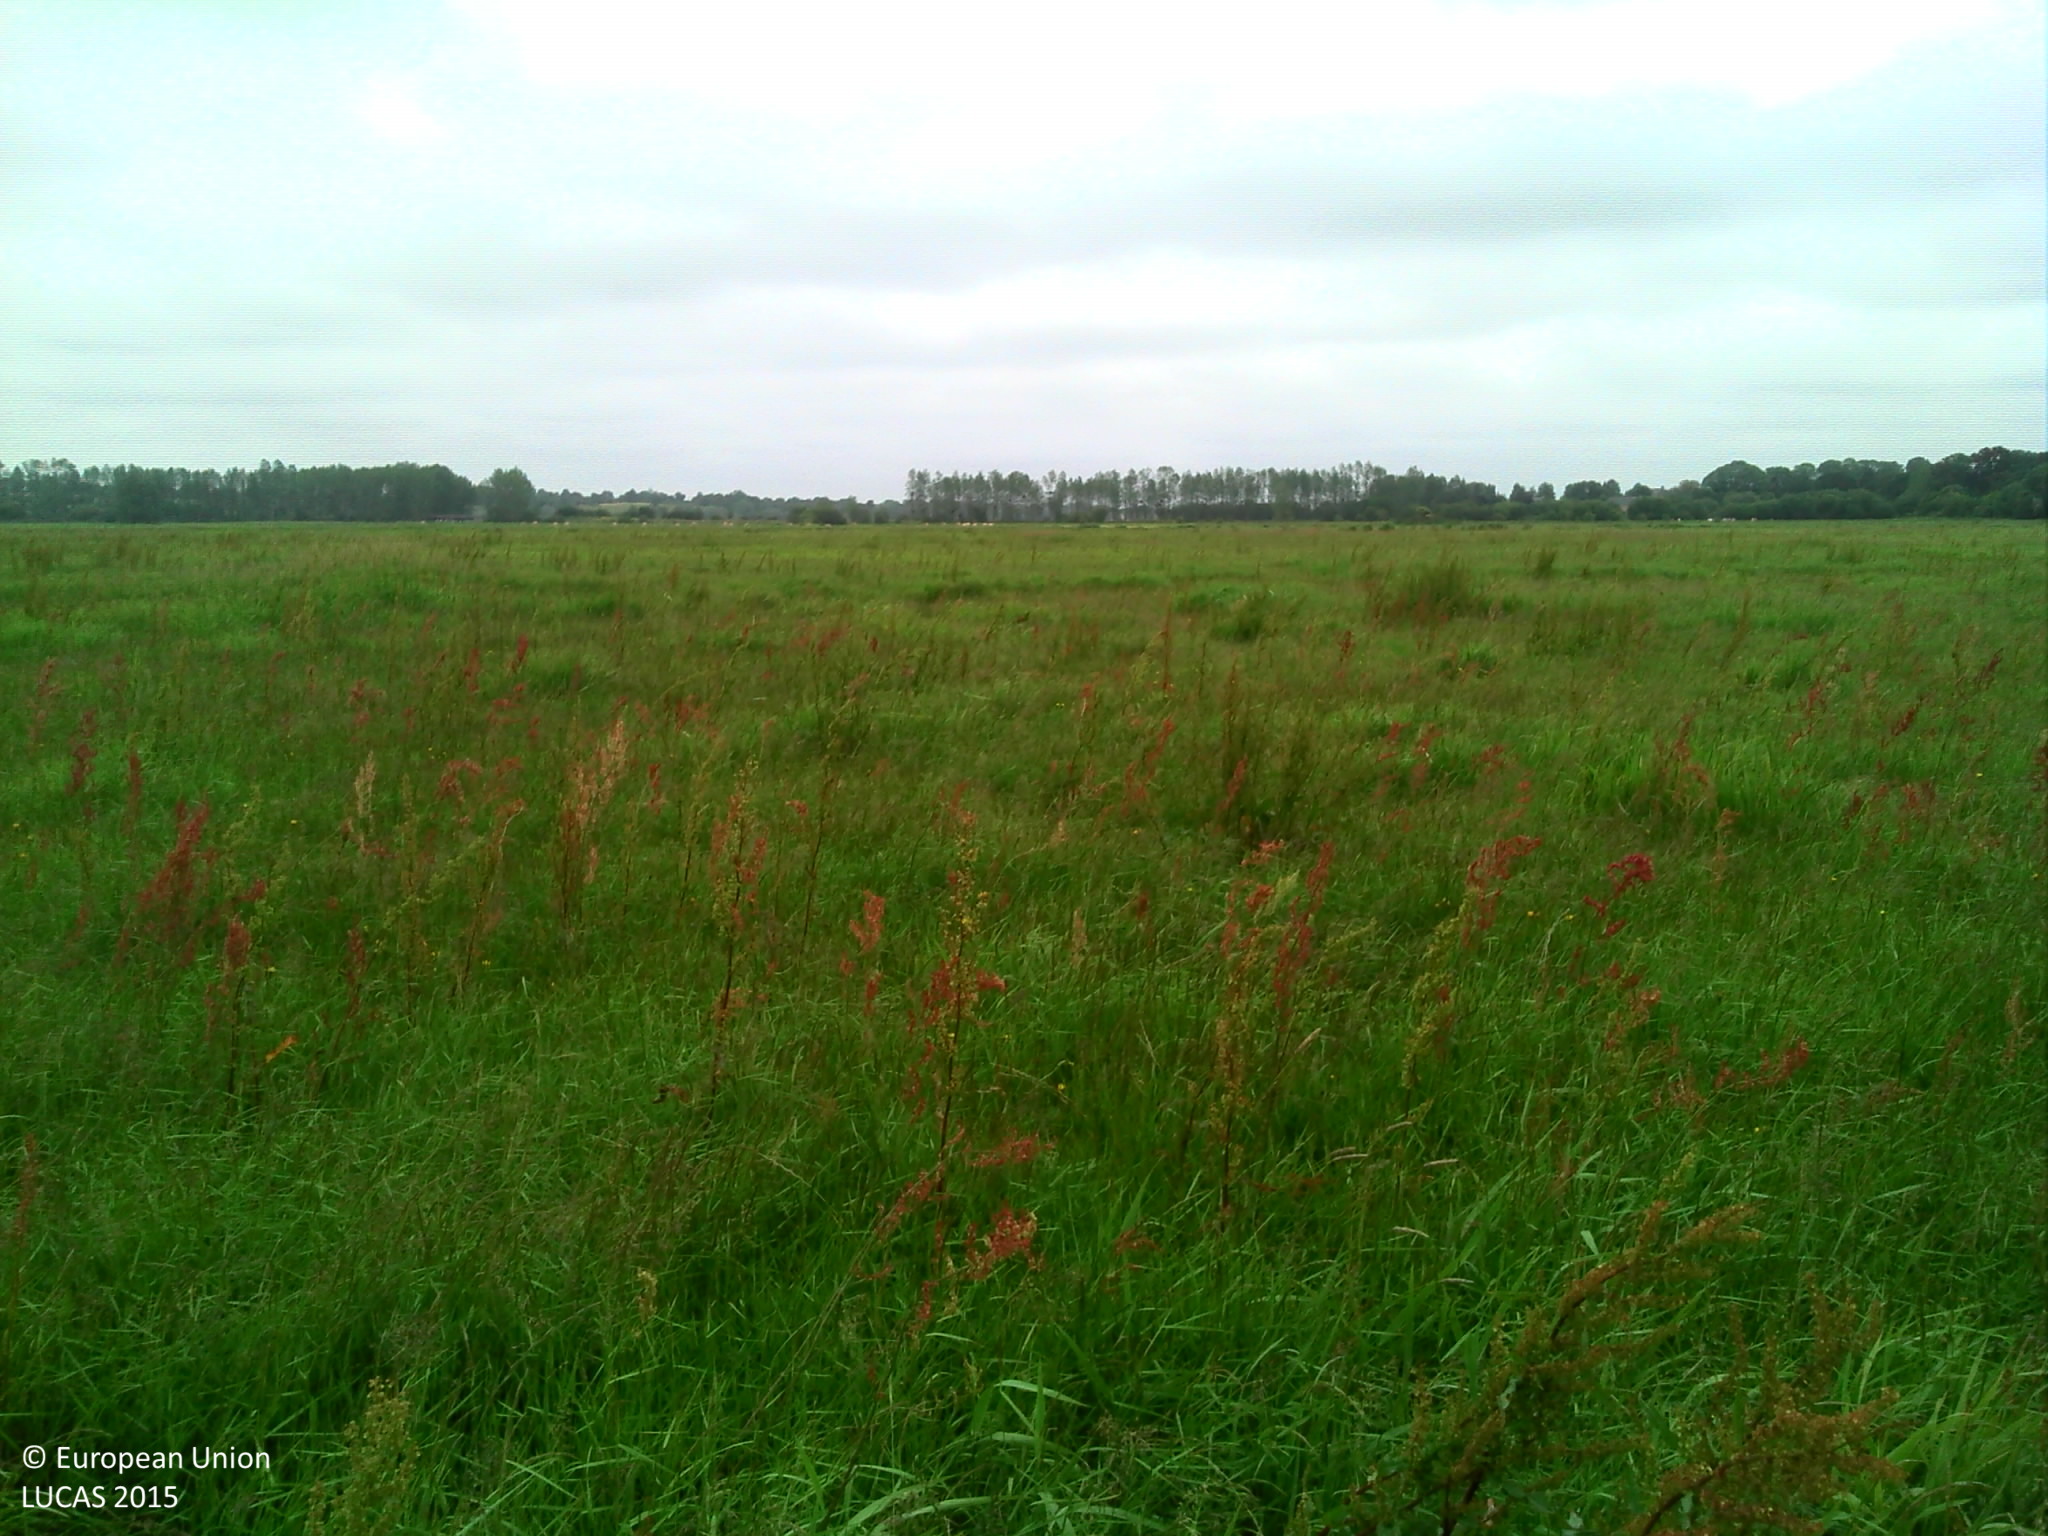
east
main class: Grassland
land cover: Grassland without tree/shrub cover
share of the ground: > 75 %
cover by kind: herbaceous plants 100 %
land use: Agriculture (excluding fallow land and kitchen gardens)
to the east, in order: Grassland without tree/shrub cover; Rivers and streams; Grassland without tree/shrub cover; Rivers and streams; Grassland without tree/shrub cover
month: June
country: FR
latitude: 49.3704
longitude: -1.4374
